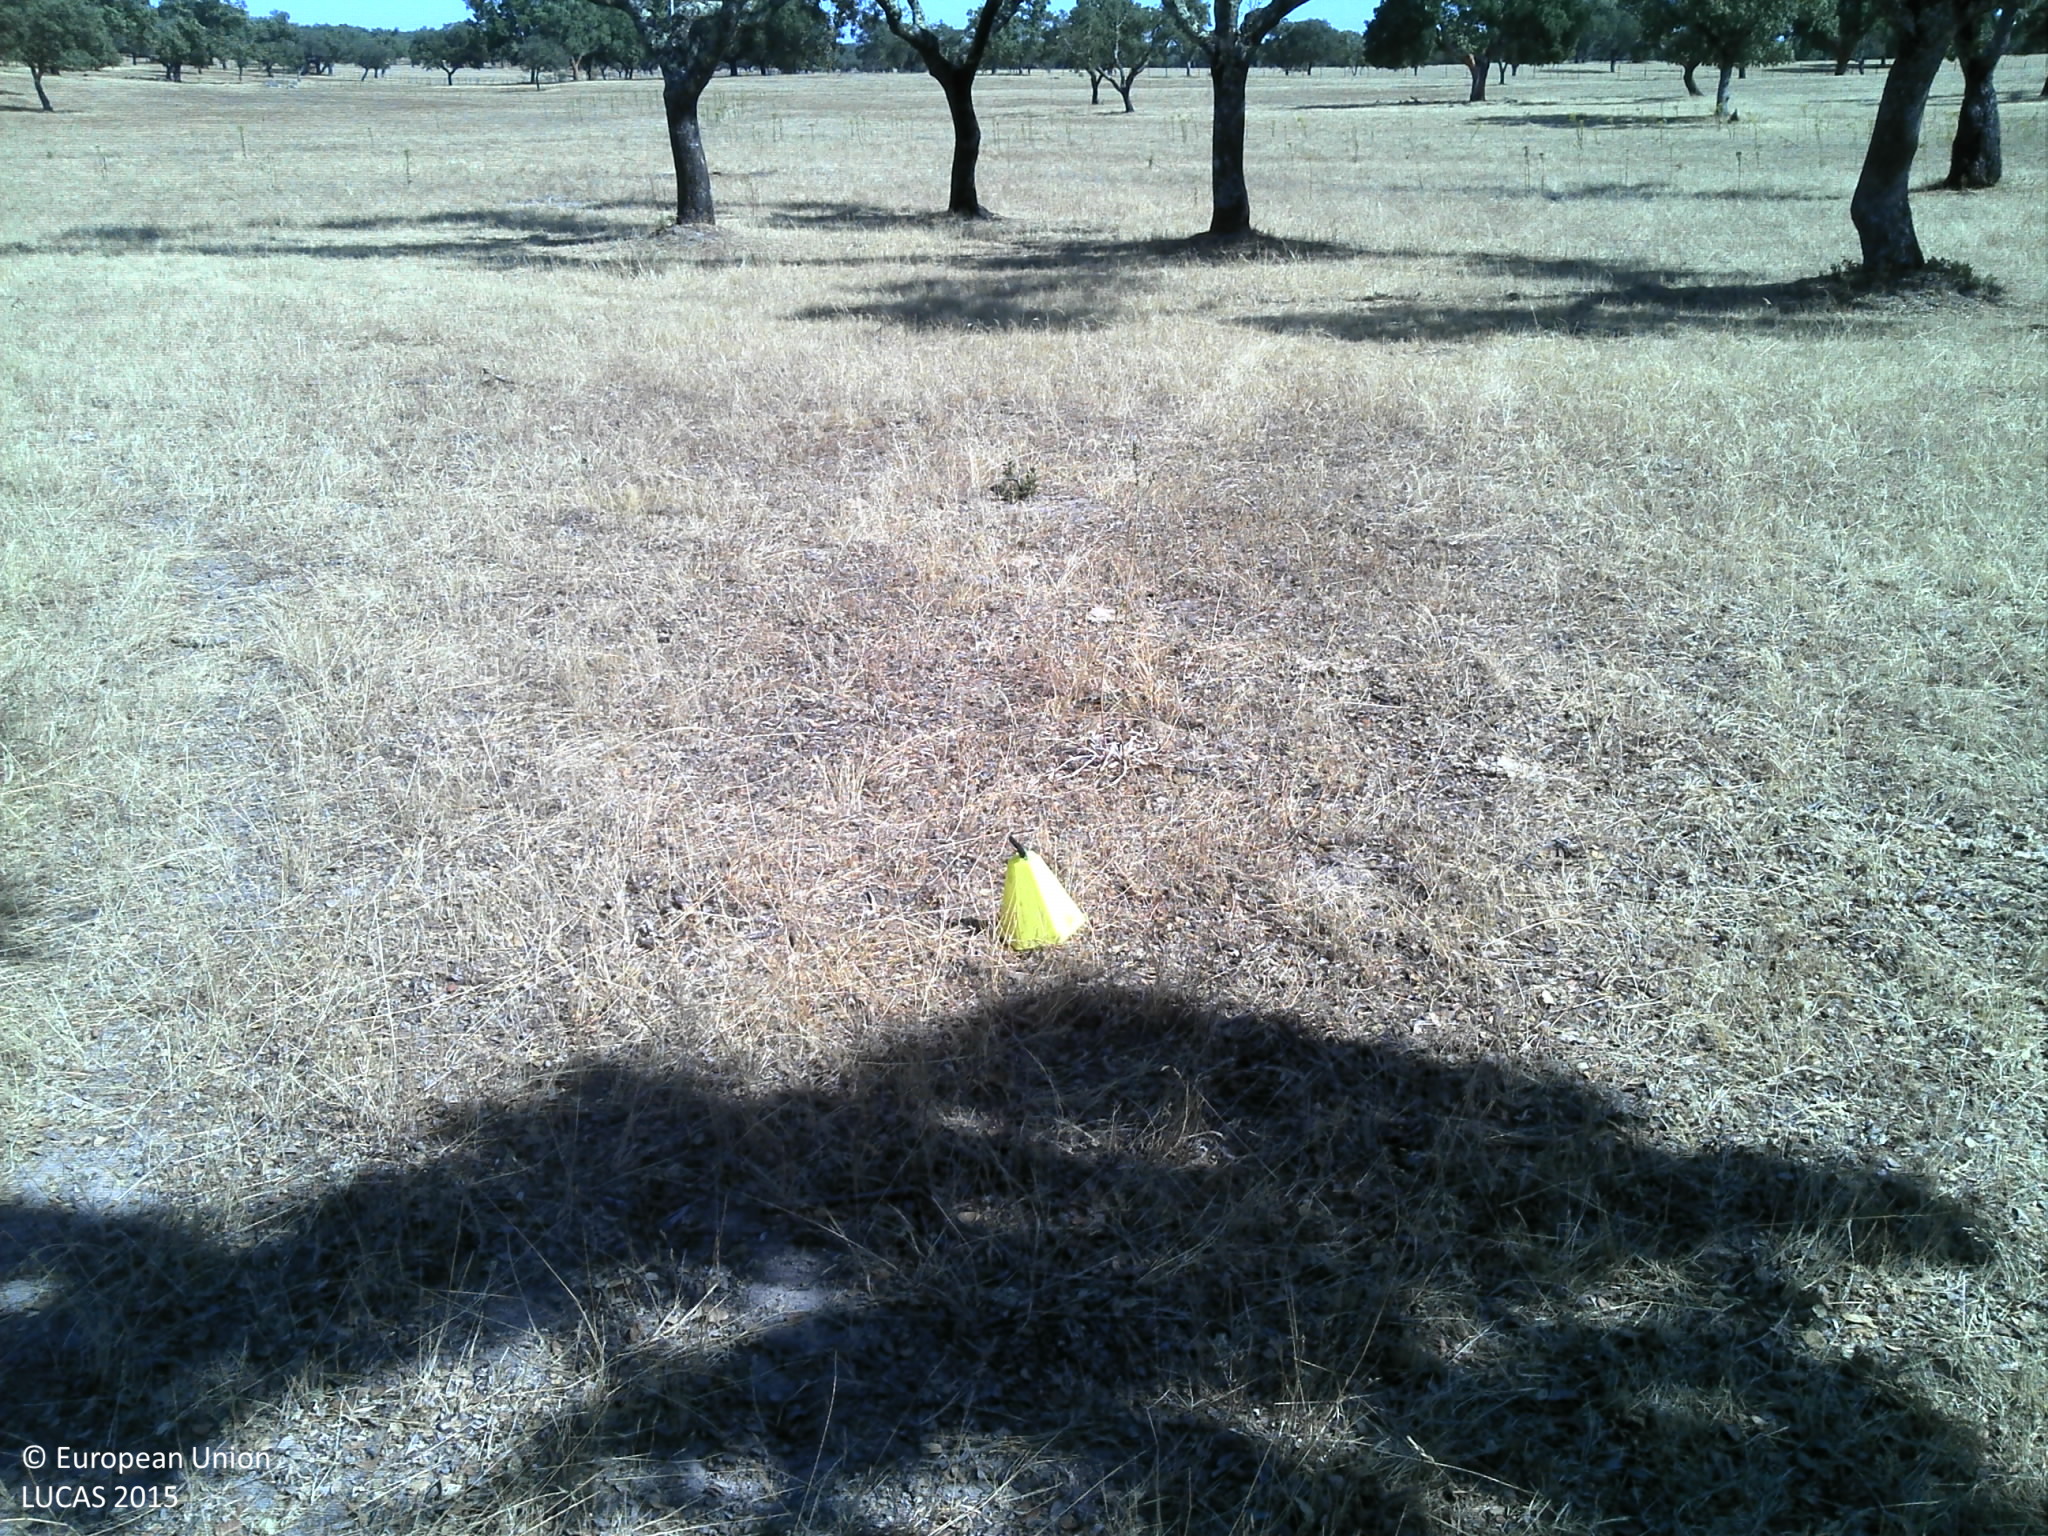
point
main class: Woodland
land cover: Broadleaved woodland
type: broadleaved evergreen forest
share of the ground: 25 - 50 %
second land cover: Grassland without tree/shrub cover
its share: 10 - 25 %
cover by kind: unconsolidated bare surface 50 %, broadleaved forest trees 30 %, herbaceous plants 20 %
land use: Forestry
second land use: Agriculture (excluding fallow land and kitchen gardens)
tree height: > 5 m
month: July
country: PT
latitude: 39.3408
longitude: -7.6248
